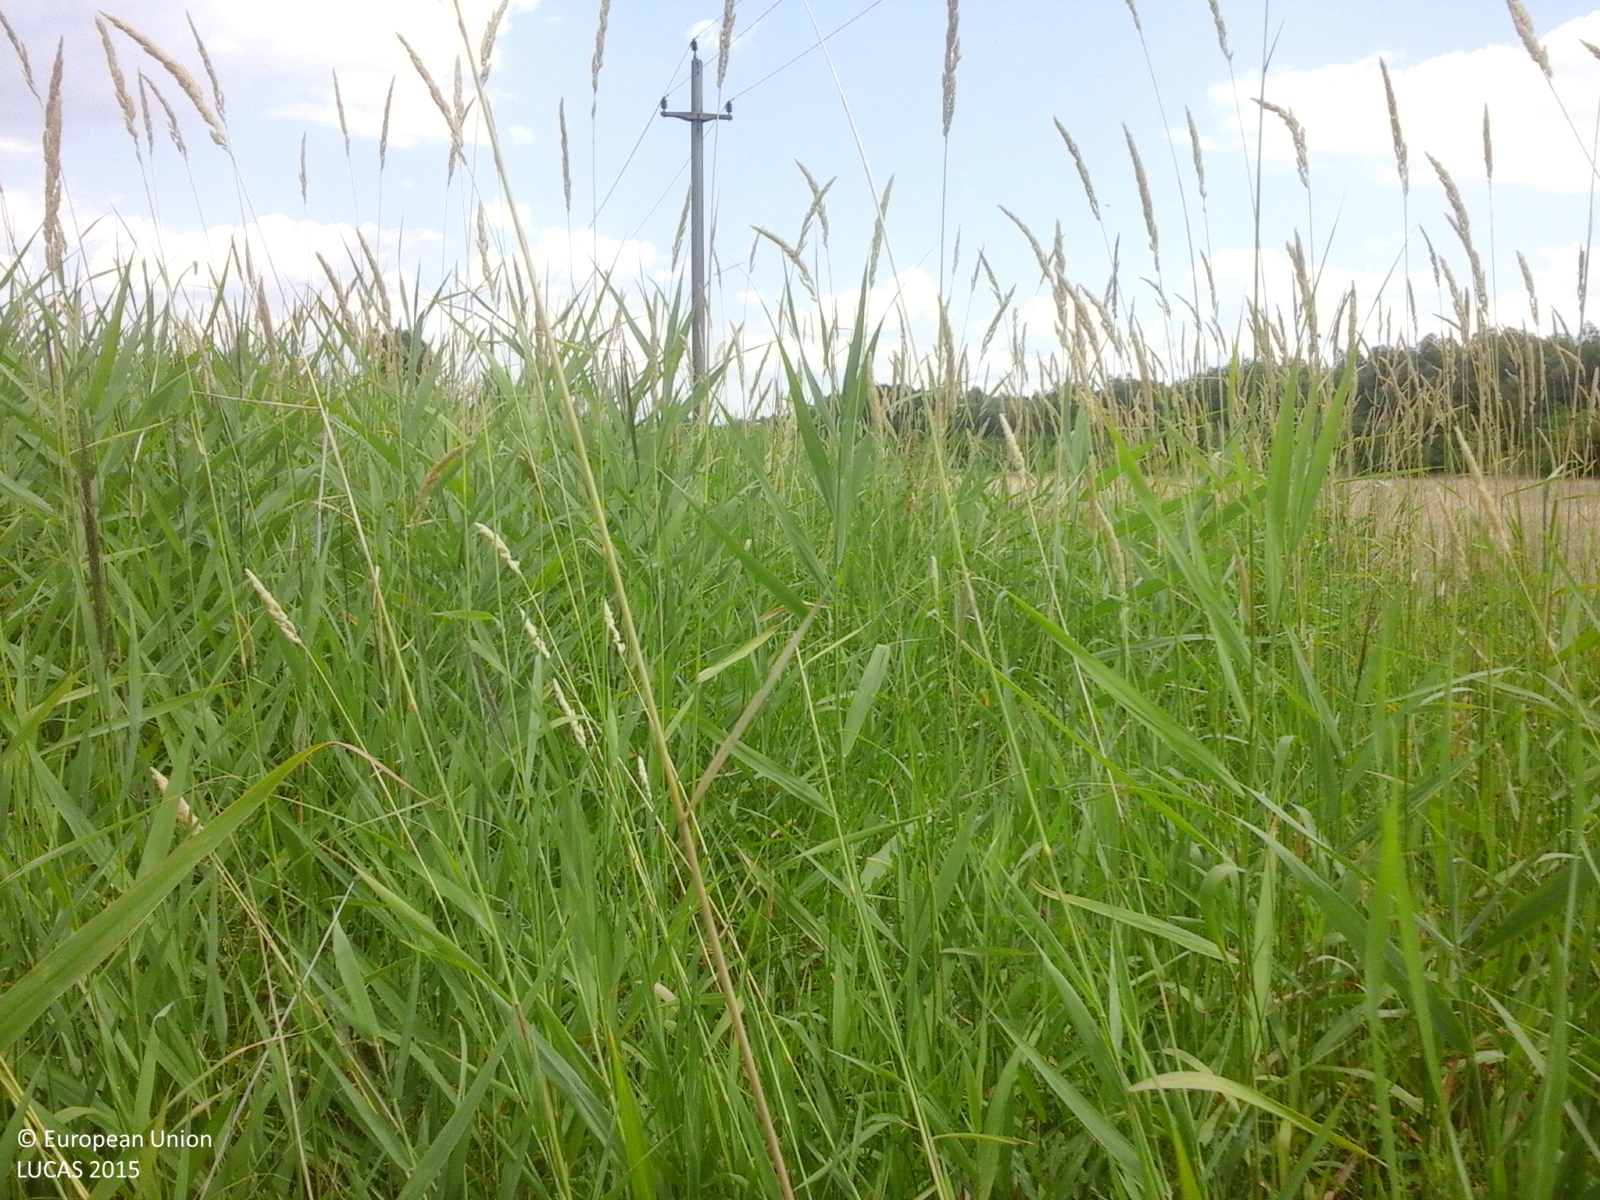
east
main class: Grassland
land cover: Spontaneously vegetated surfaces
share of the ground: > 75 %
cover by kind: herbaceous plants 100 %
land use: Fallow land
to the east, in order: Spontaneously vegetated surfaces; Electric lines; Spontaneously vegetated surfaces
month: June
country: RO
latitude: 44.0617
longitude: 26.5279
